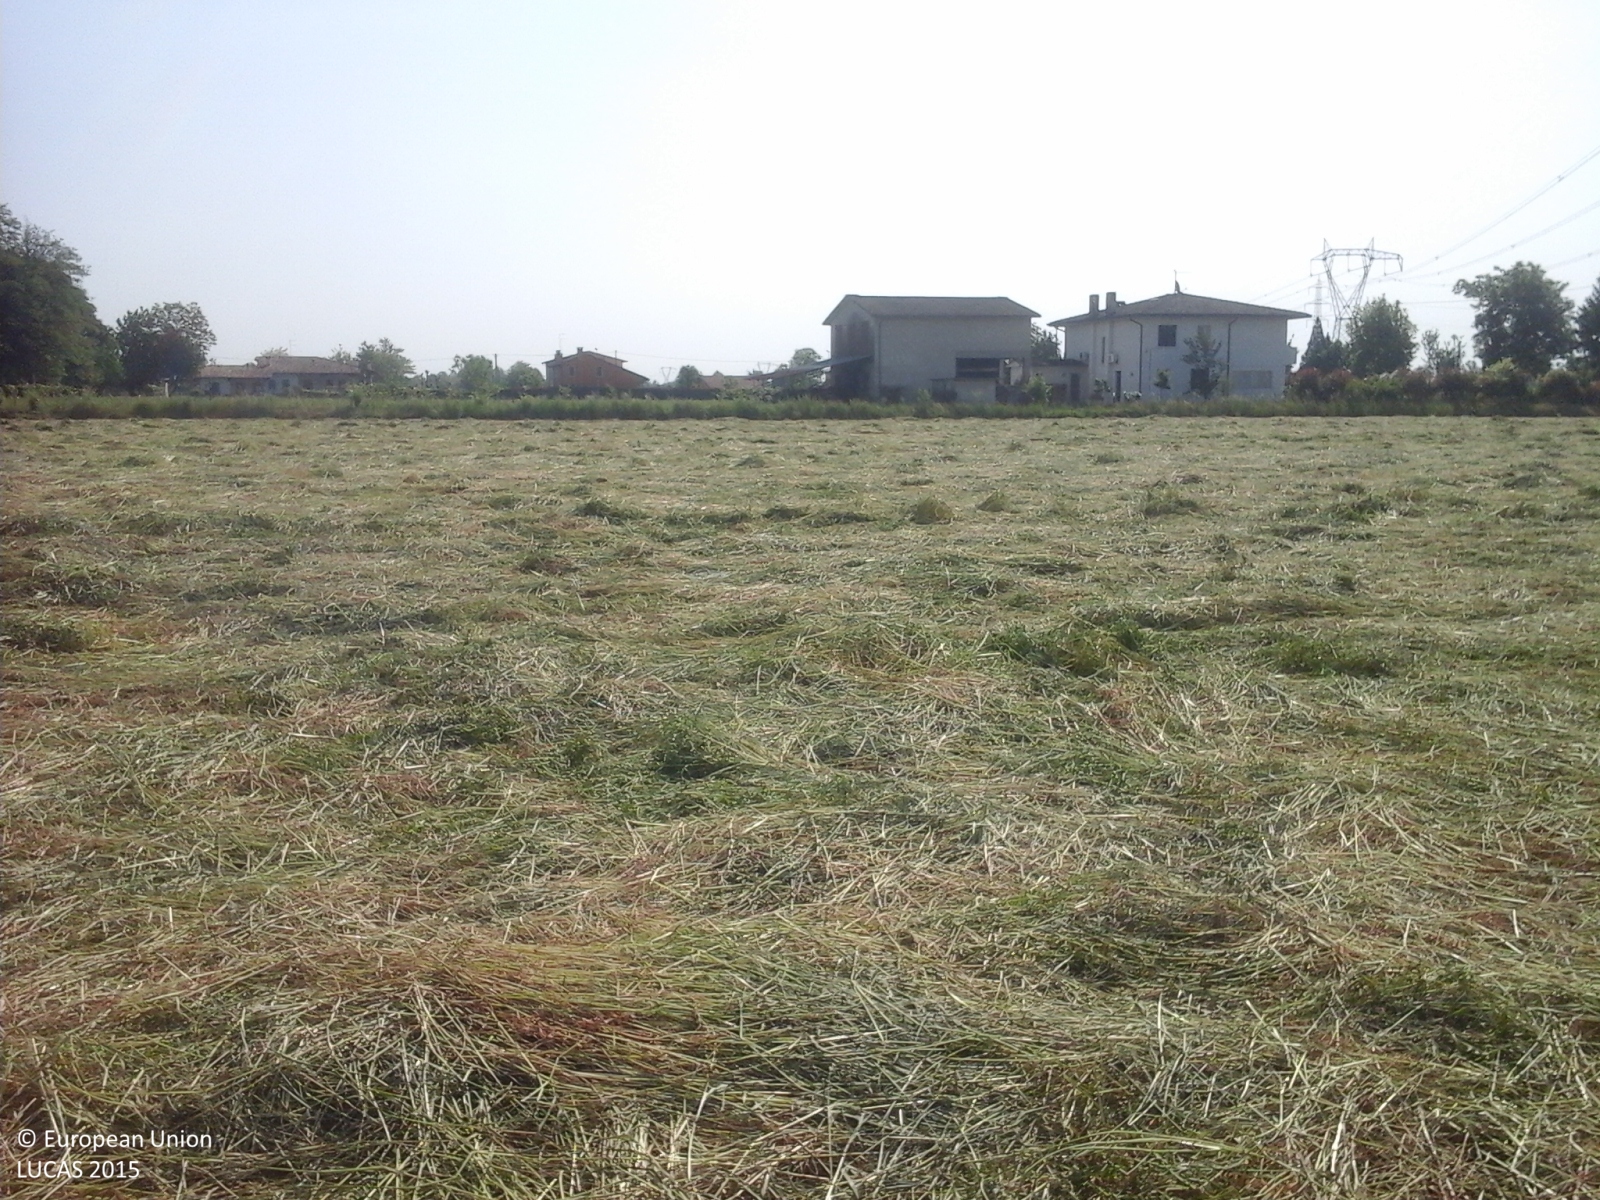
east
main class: Cropland
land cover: Temporary grasslands
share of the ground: > 75 %
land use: Agriculture (excluding fallow land and kitchen gardens)
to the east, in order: Temporary grasslands; Grass margins; Managed hedges; Ditches and canals; Vineyards; Grassland without tree/shrub cover; Artificial constructions in urban areas; Grassland without tree/shrub cover; Ditches and canals; Grassland without tree/shrub cover; Electric lines; Grassland without tree/shrub cover; Paved roads, cycling and walking lanes; Artificial constructions in urban areas
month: May
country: IT
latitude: 45.6705
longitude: 11.7302
